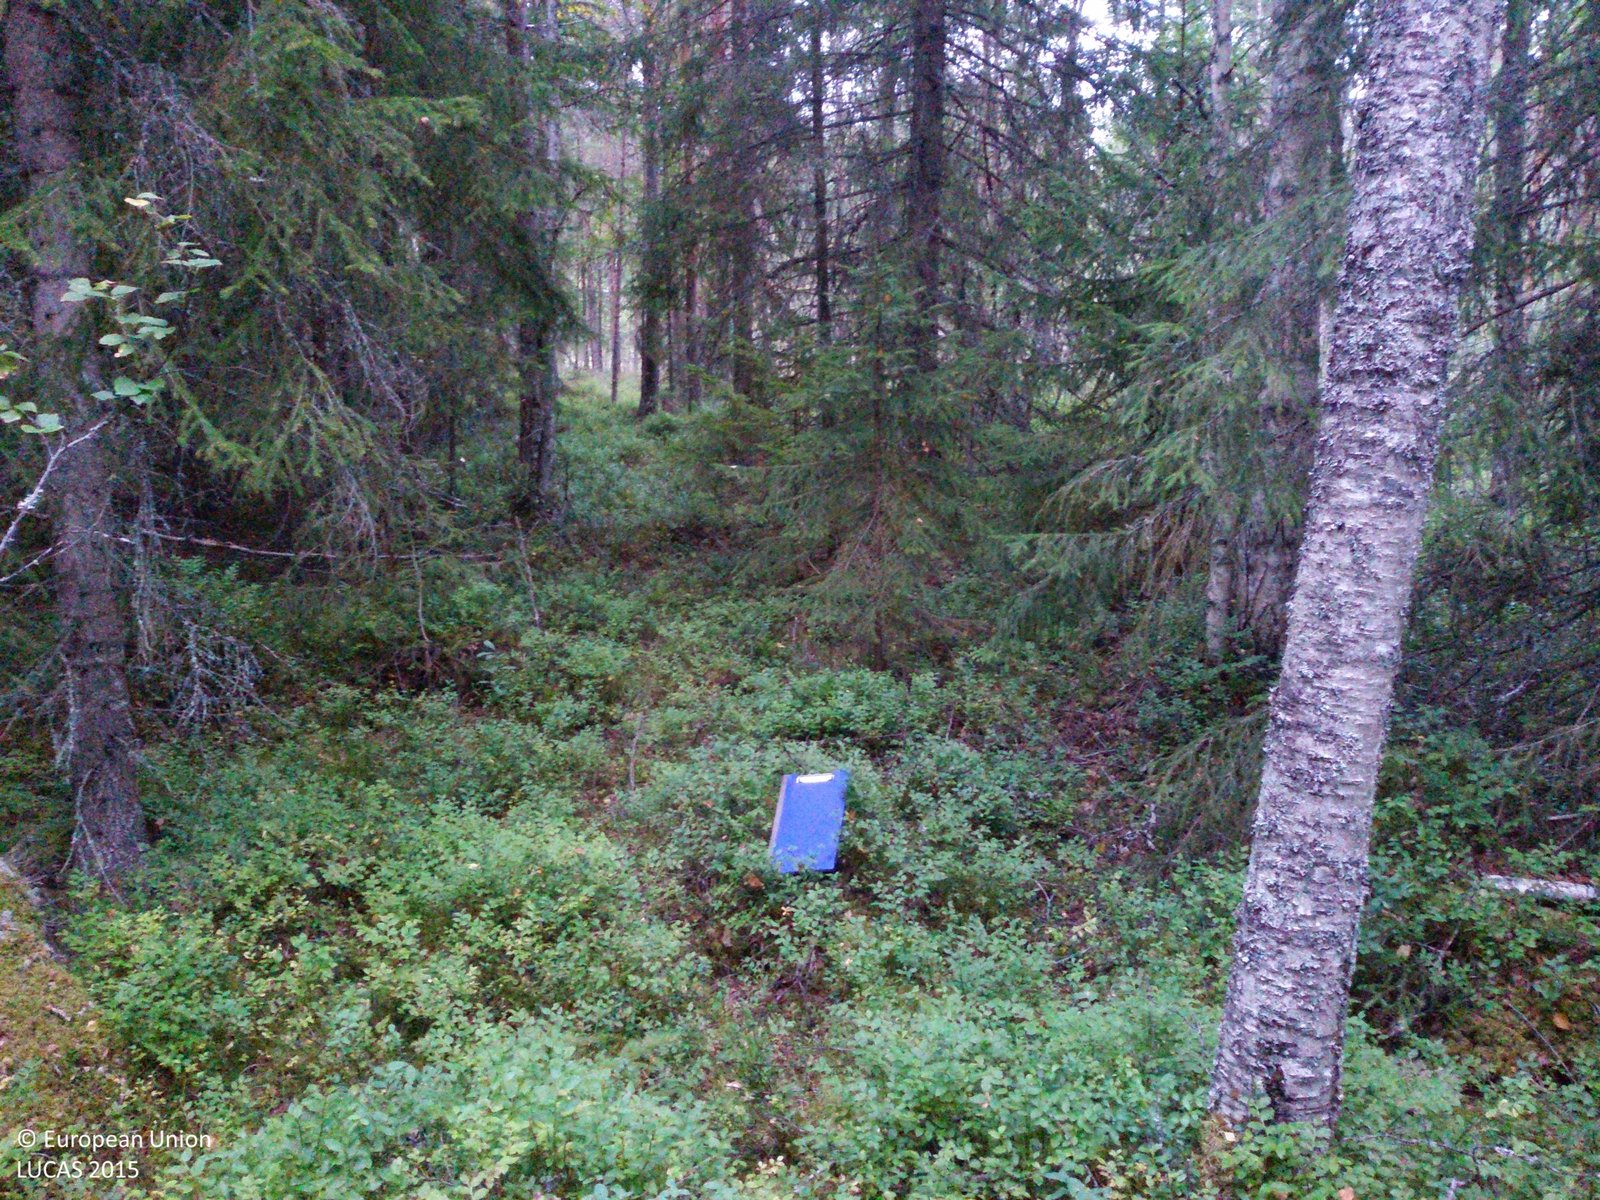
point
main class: Woodland
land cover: Spruce dominated mixed woodland
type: boreal forest
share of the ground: 50 - 75 %
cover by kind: coniferous forest trees 40 %, broadleaved forest trees 30 %, herbaceous plants 30 %
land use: Forestry
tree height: > 5 m
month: September
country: SE
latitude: 60.9866
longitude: 15.6972
